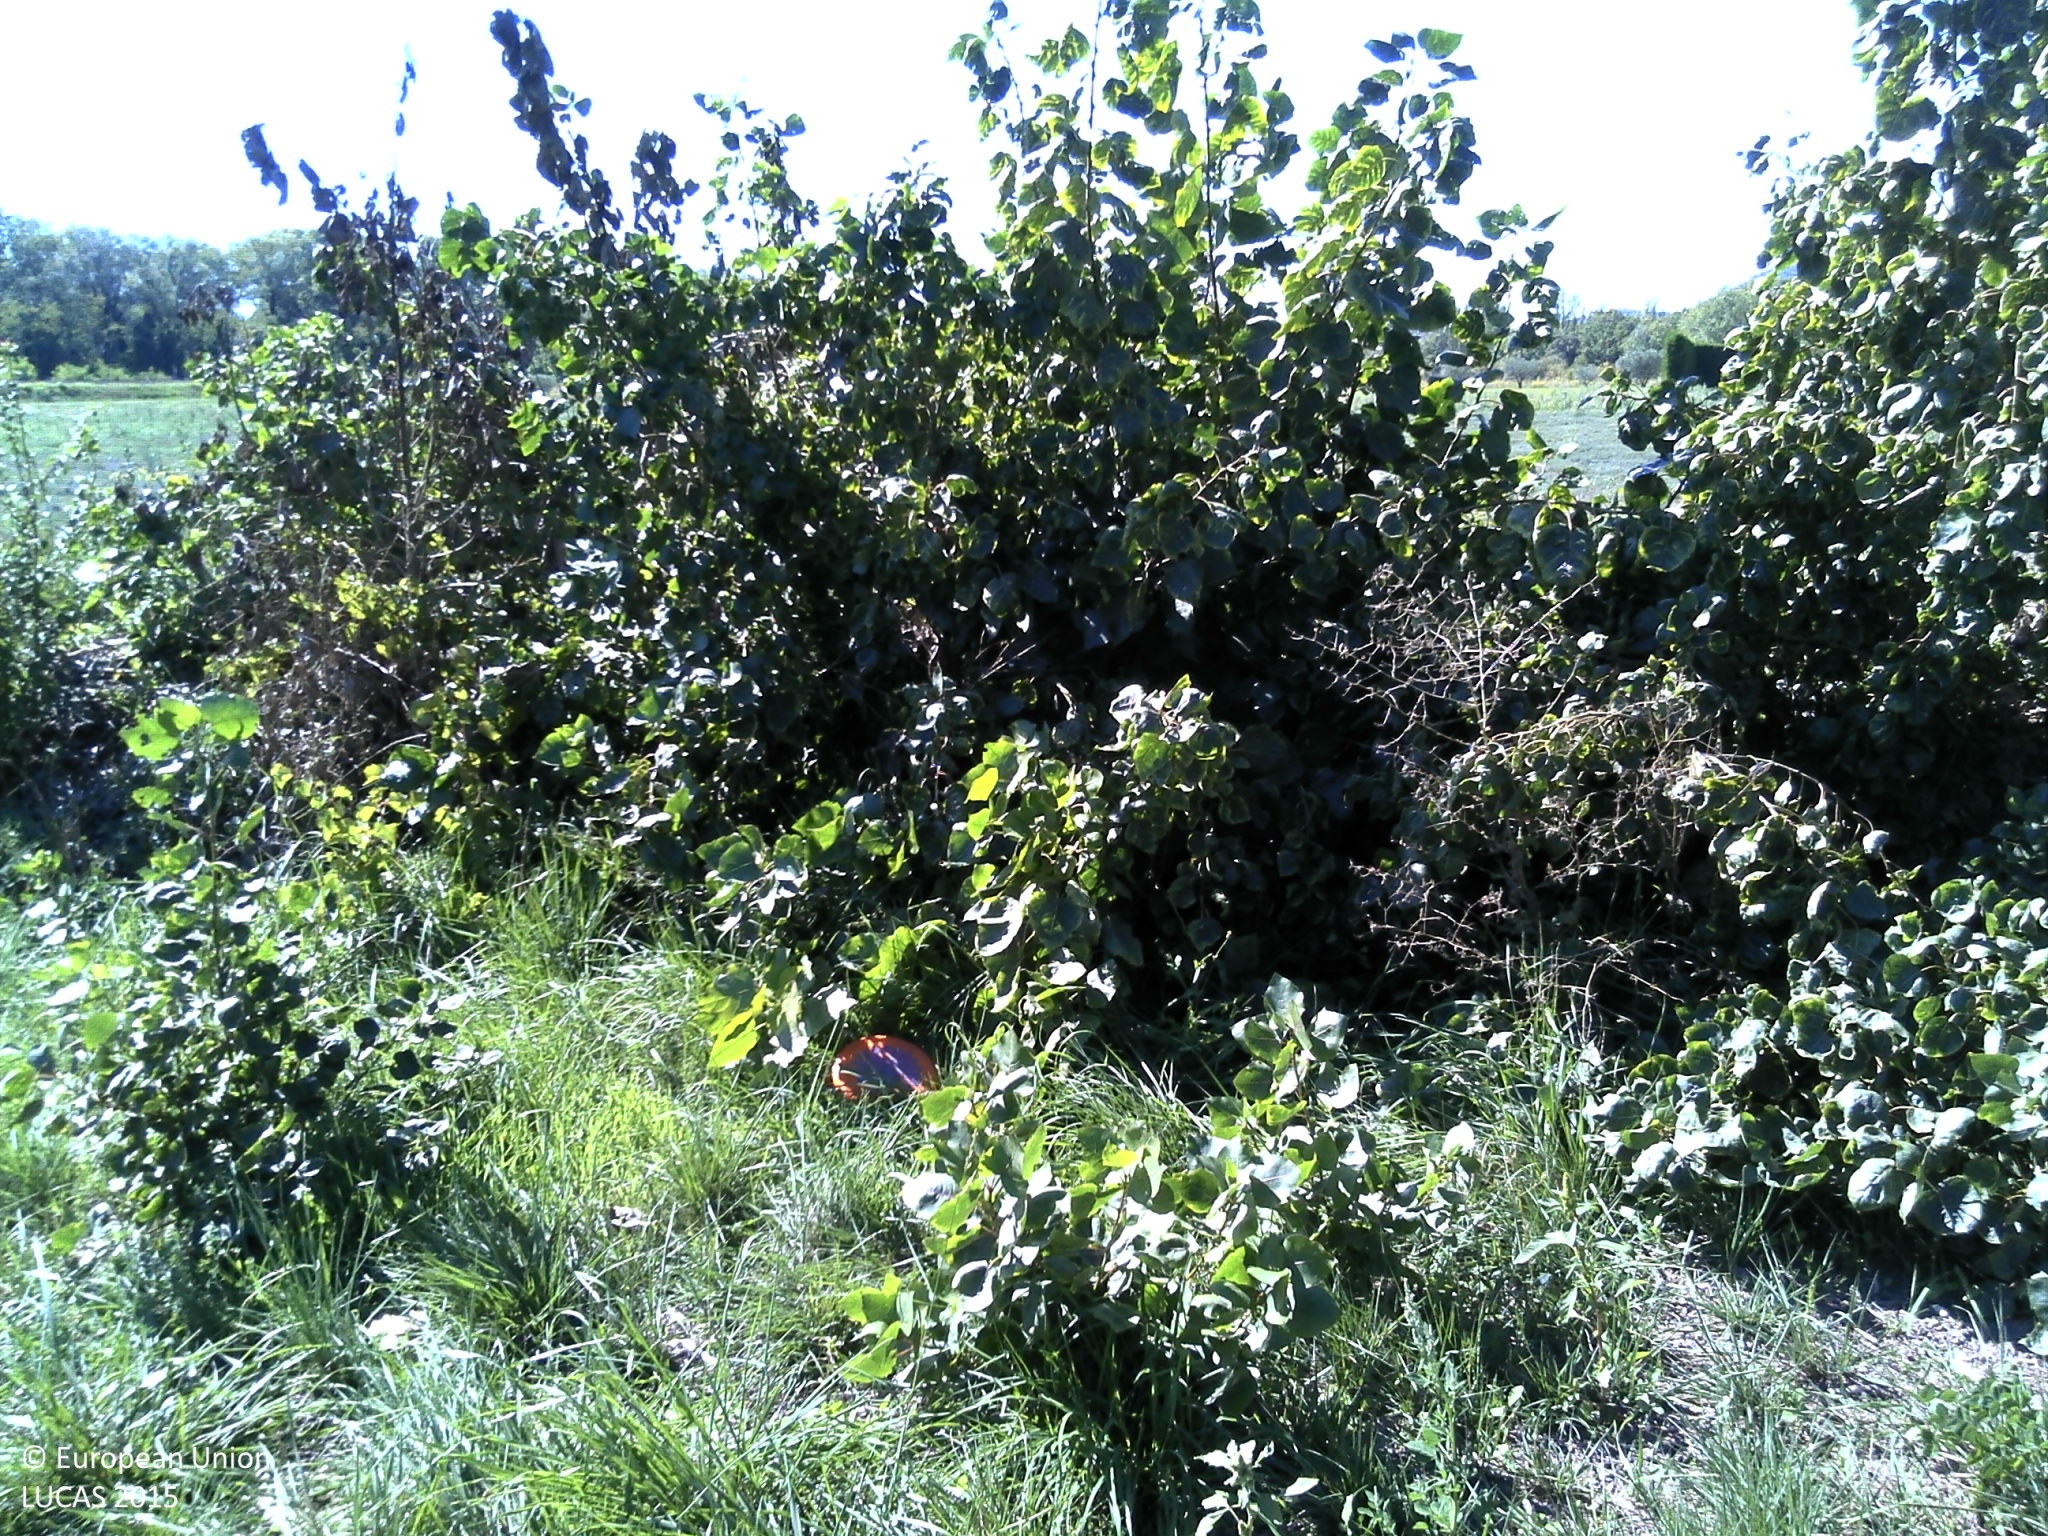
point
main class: Cropland
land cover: Pear fruit
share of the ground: 10 - 25 %
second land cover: Grassland without tree/shrub cover
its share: > 75 %
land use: Agriculture (excluding fallow land and kitchen gardens)
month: September
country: FR
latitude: 43.7541
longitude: 5.2524
